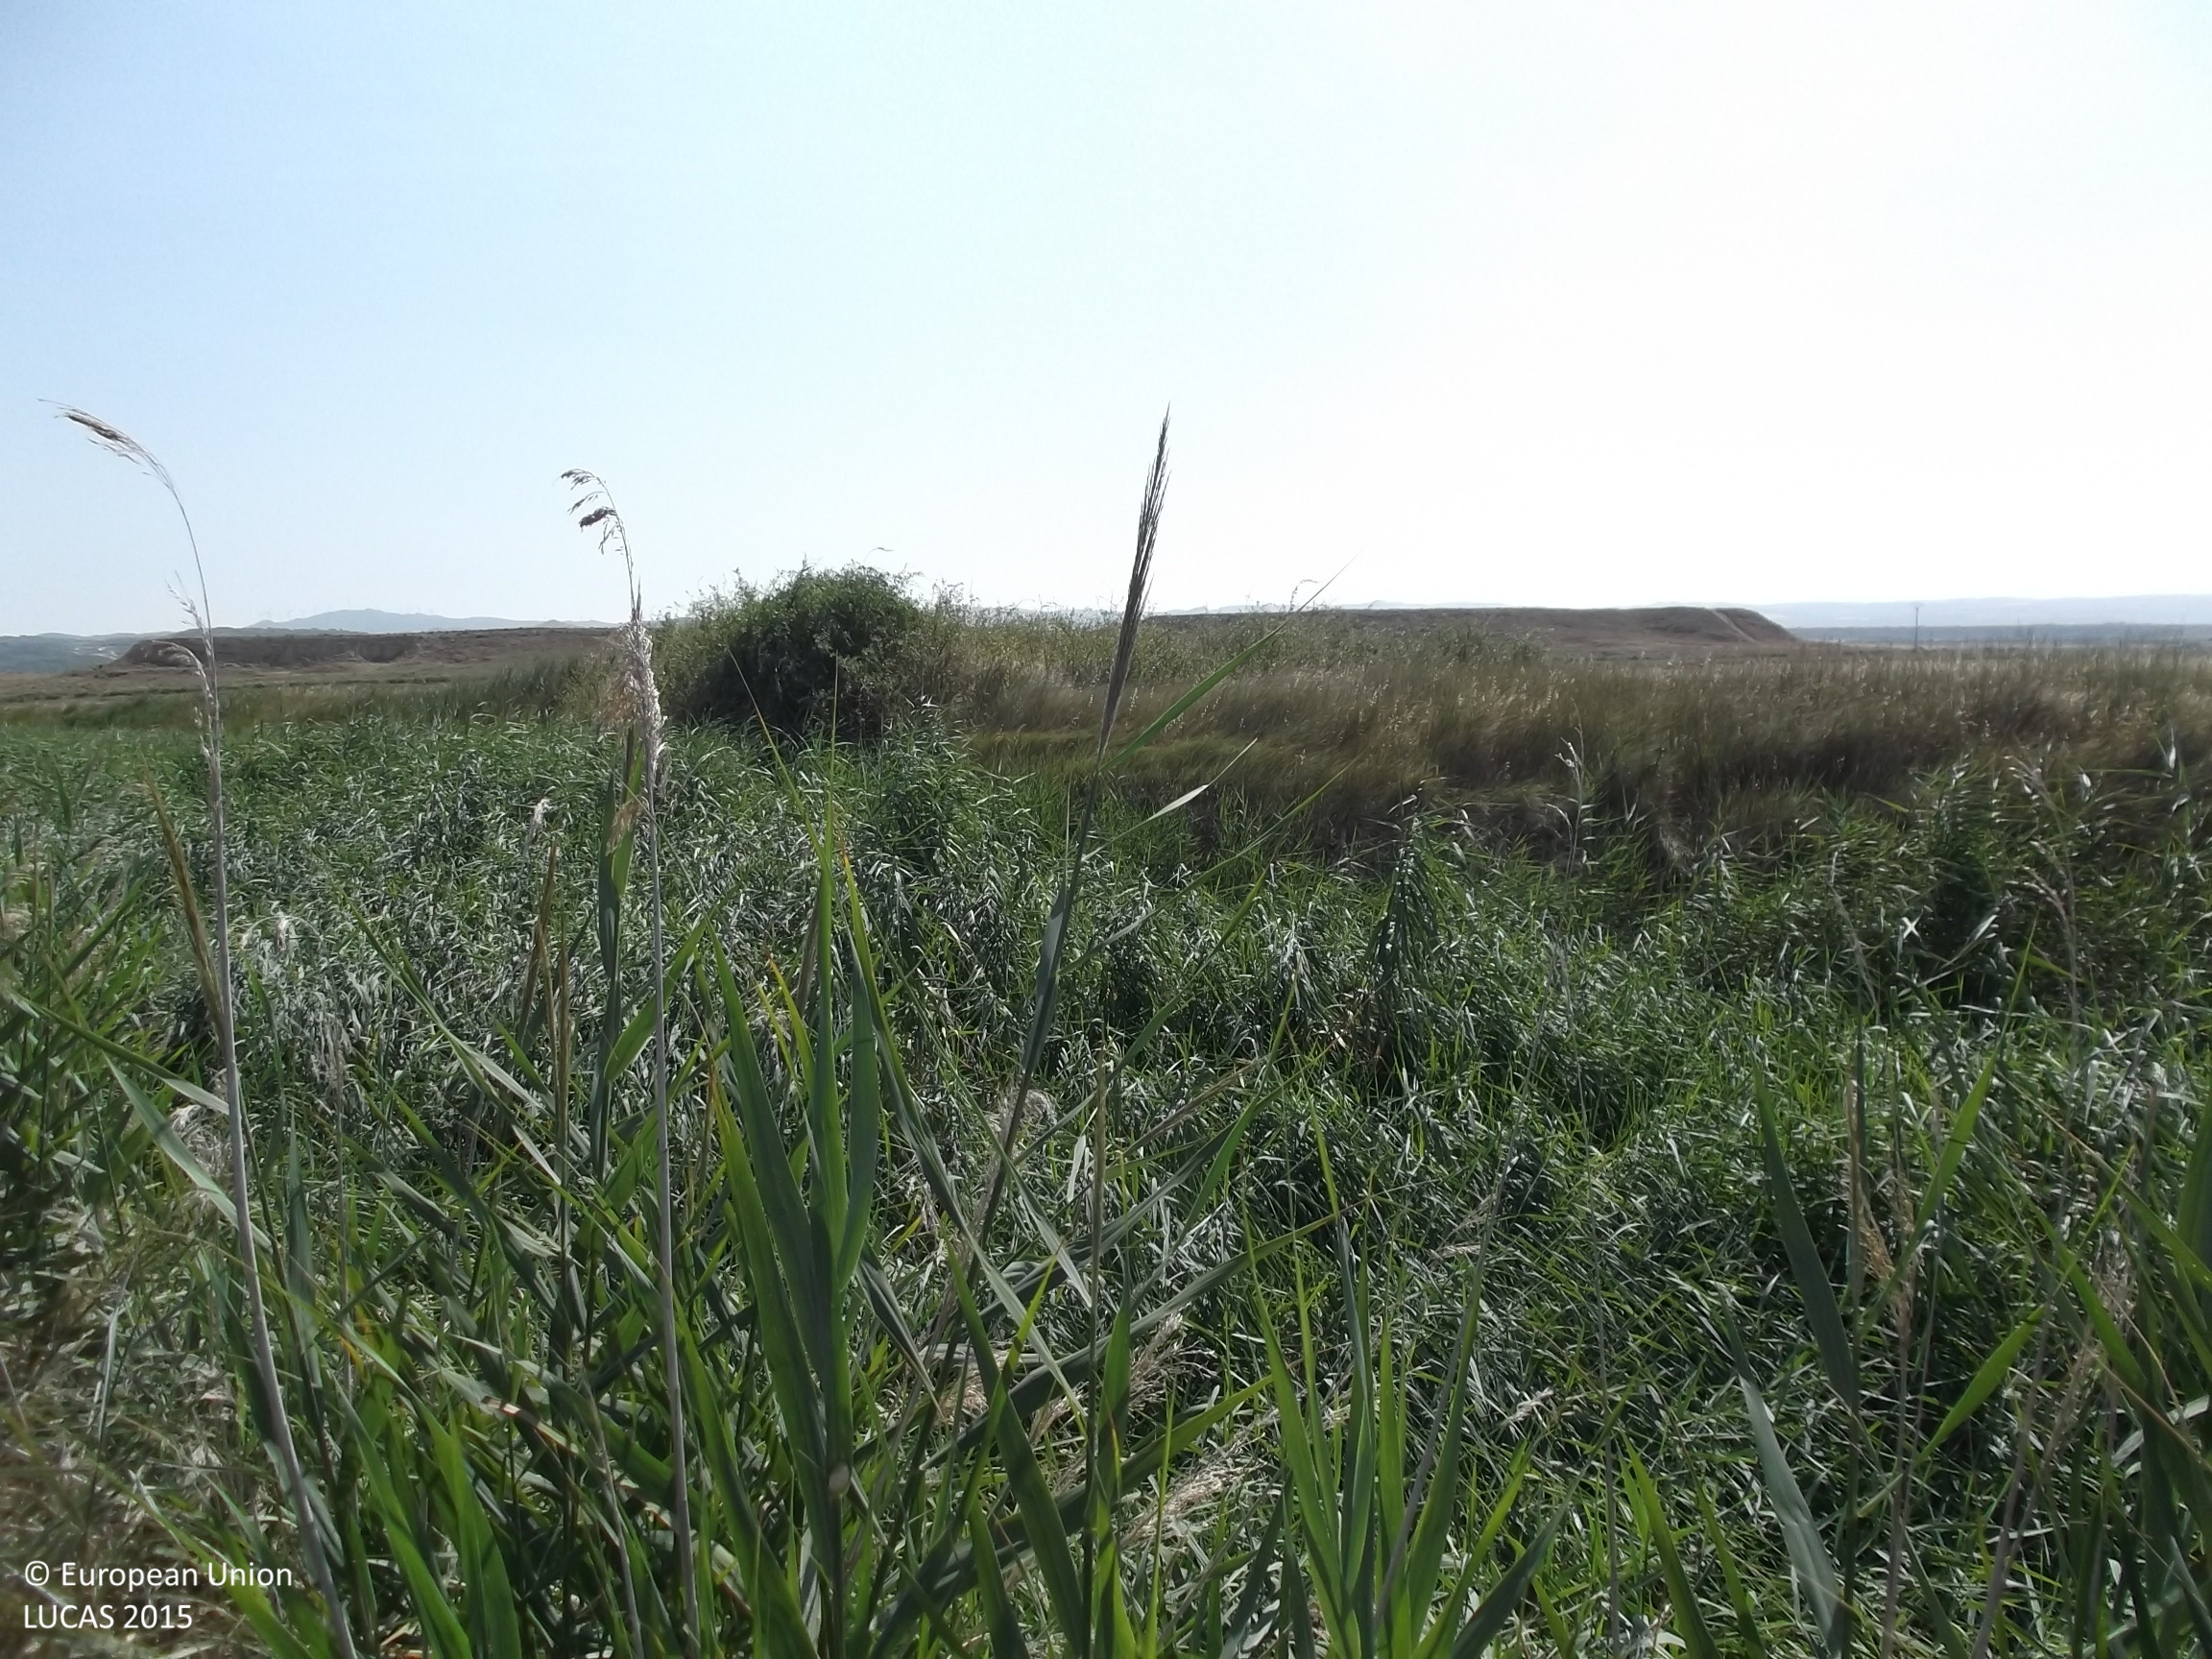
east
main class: Grassland
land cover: Grassland without tree/shrub cover
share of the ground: > 75 %
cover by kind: herbaceous plants 95 %
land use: Semi-natural and natural areas not in use
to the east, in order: Grassland without tree/shrub cover; Rivers and streams; Grassland without tree/shrub cover; Other bare soil
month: July
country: ES
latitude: 42.4919
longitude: -1.6312
